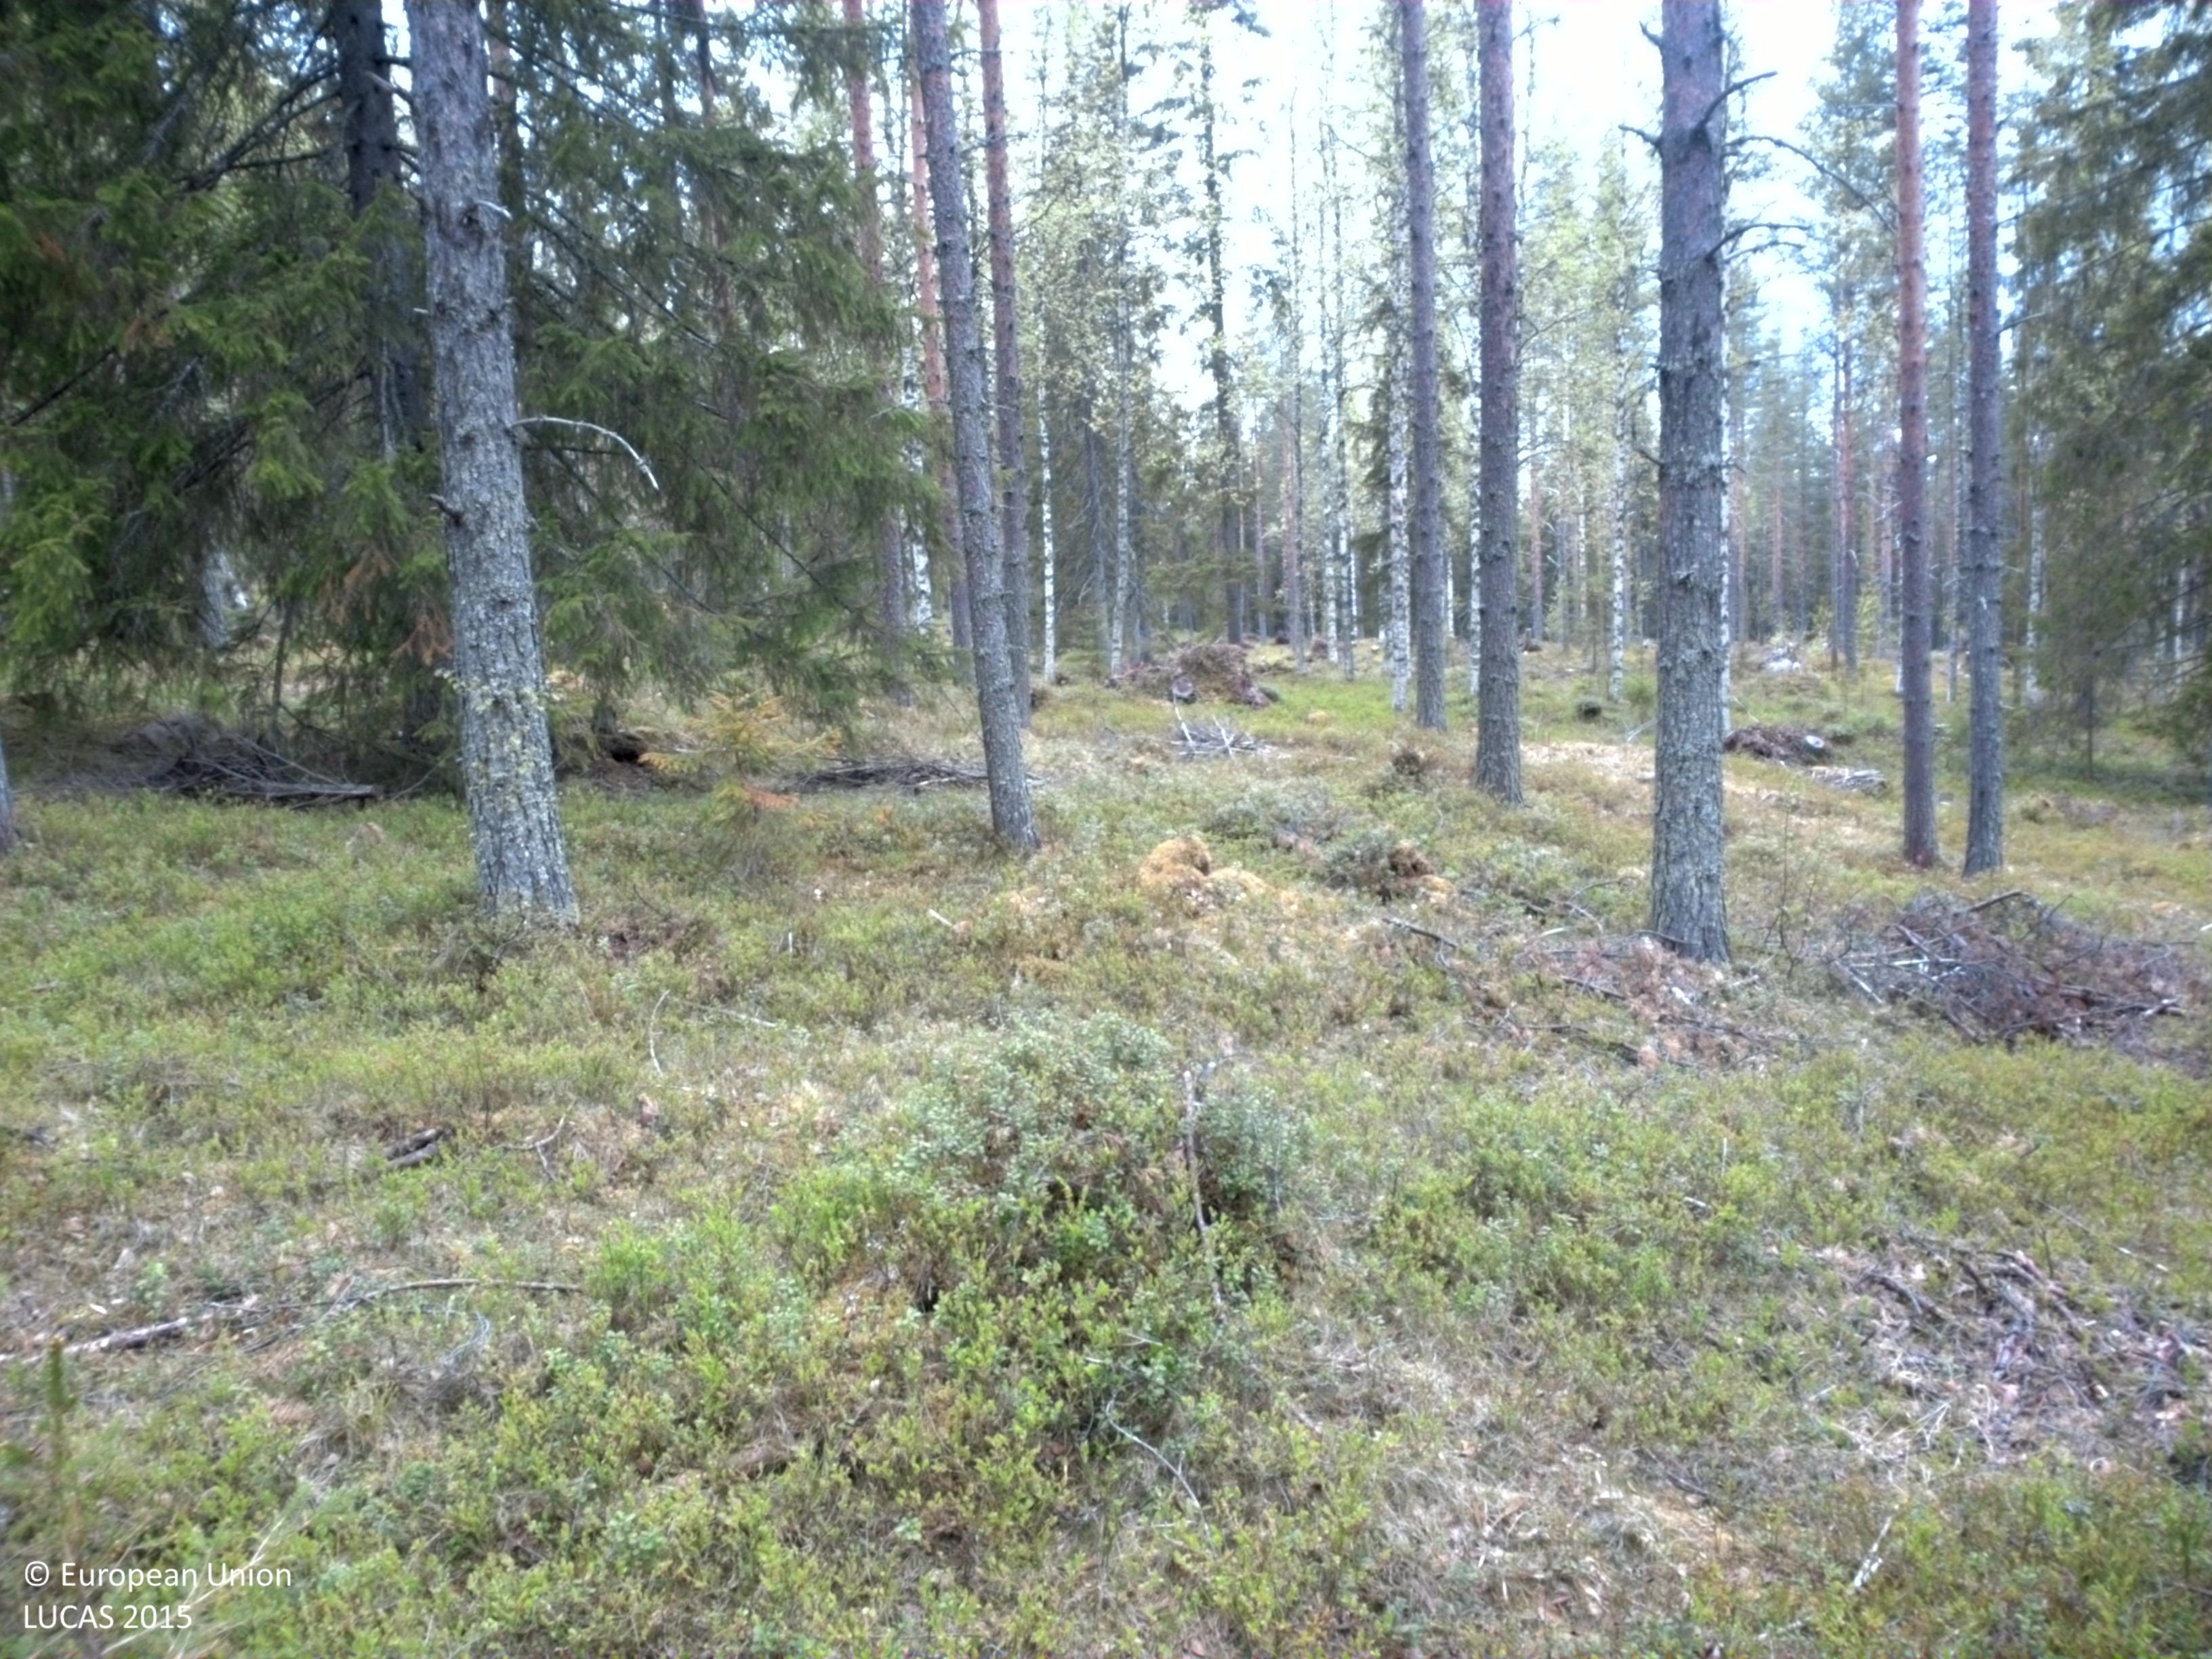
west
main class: Woodland
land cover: Pine dominated mixed woodland
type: boreal forest
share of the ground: 25 - 50 %
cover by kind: herbaceous plants 40 %, coniferous forest trees 35 %, broadleaved forest trees 15 %, lichens and mosses 5 %, unconsolidated bare surface 5 %
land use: Forestry
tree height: > 5 m
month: June
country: SE
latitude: 64.1915
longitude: 17.7307
